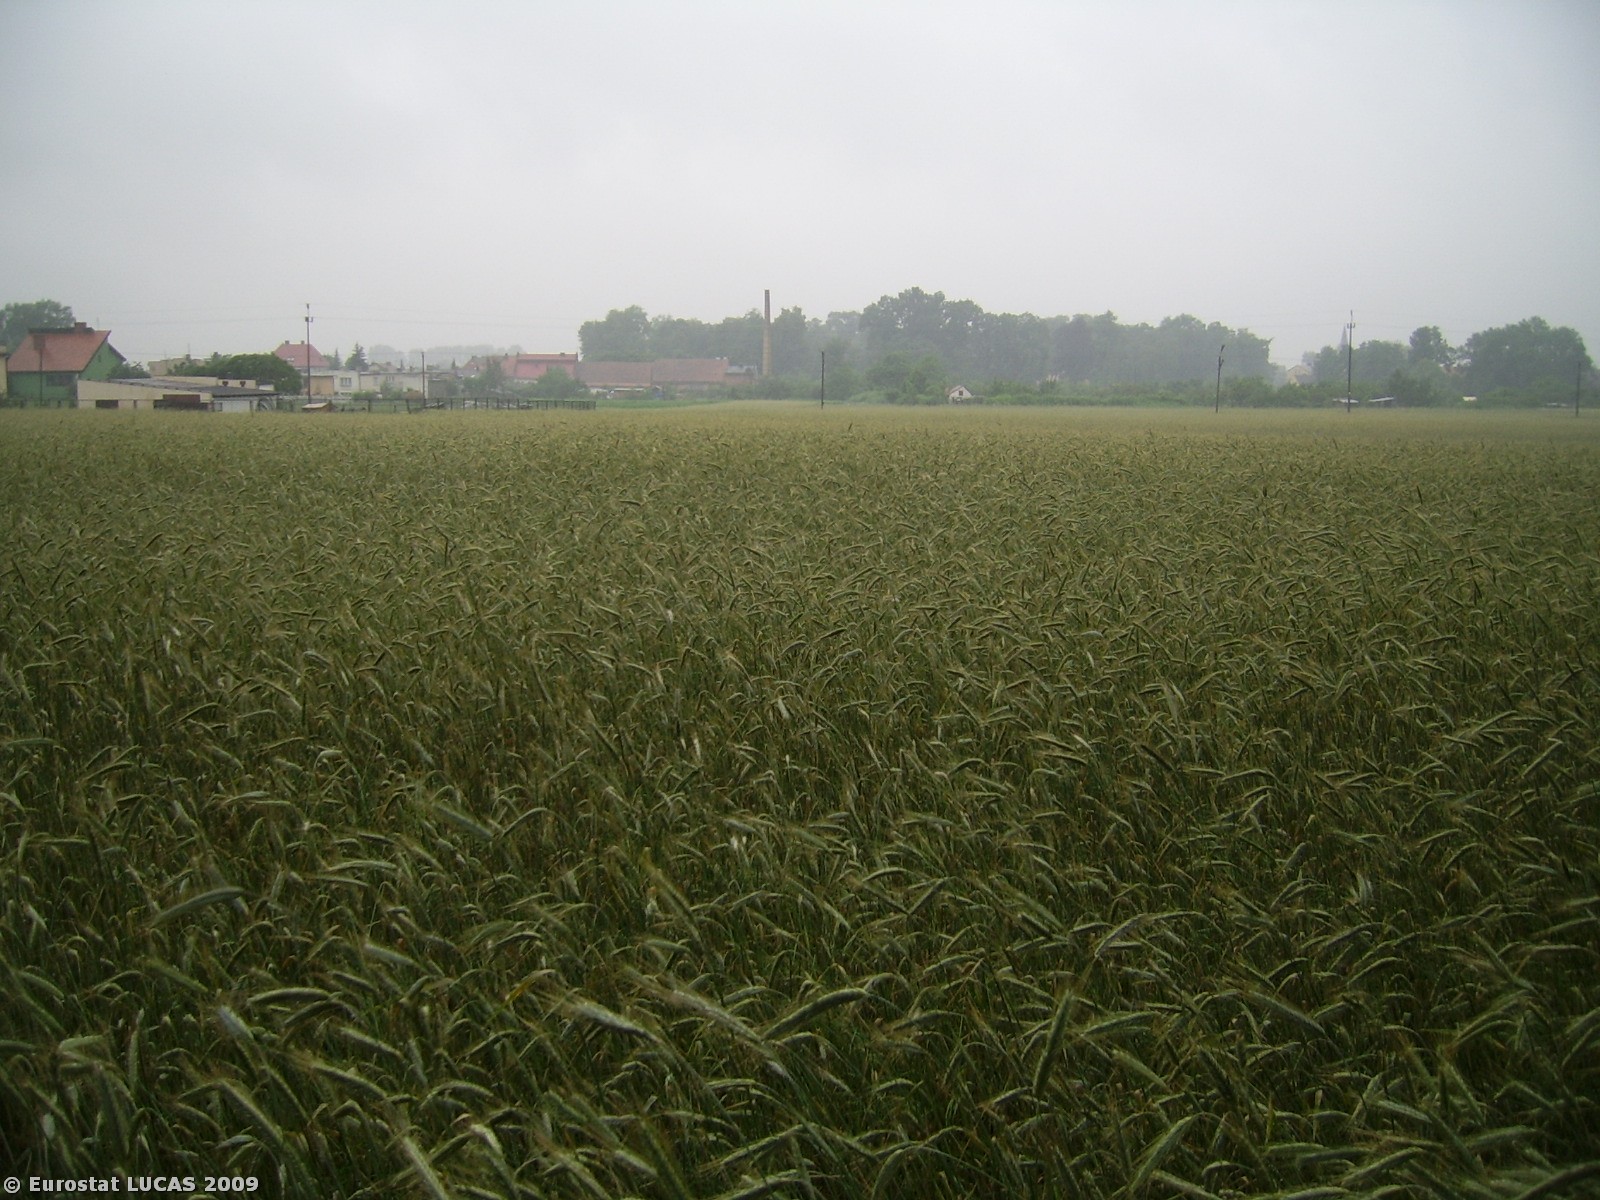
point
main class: Cropland
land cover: Rye
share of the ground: > 75 %
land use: Agriculture (excluding fallow land and kitchen gardens)
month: June
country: PL
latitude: 51.6251
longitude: 17.3646
